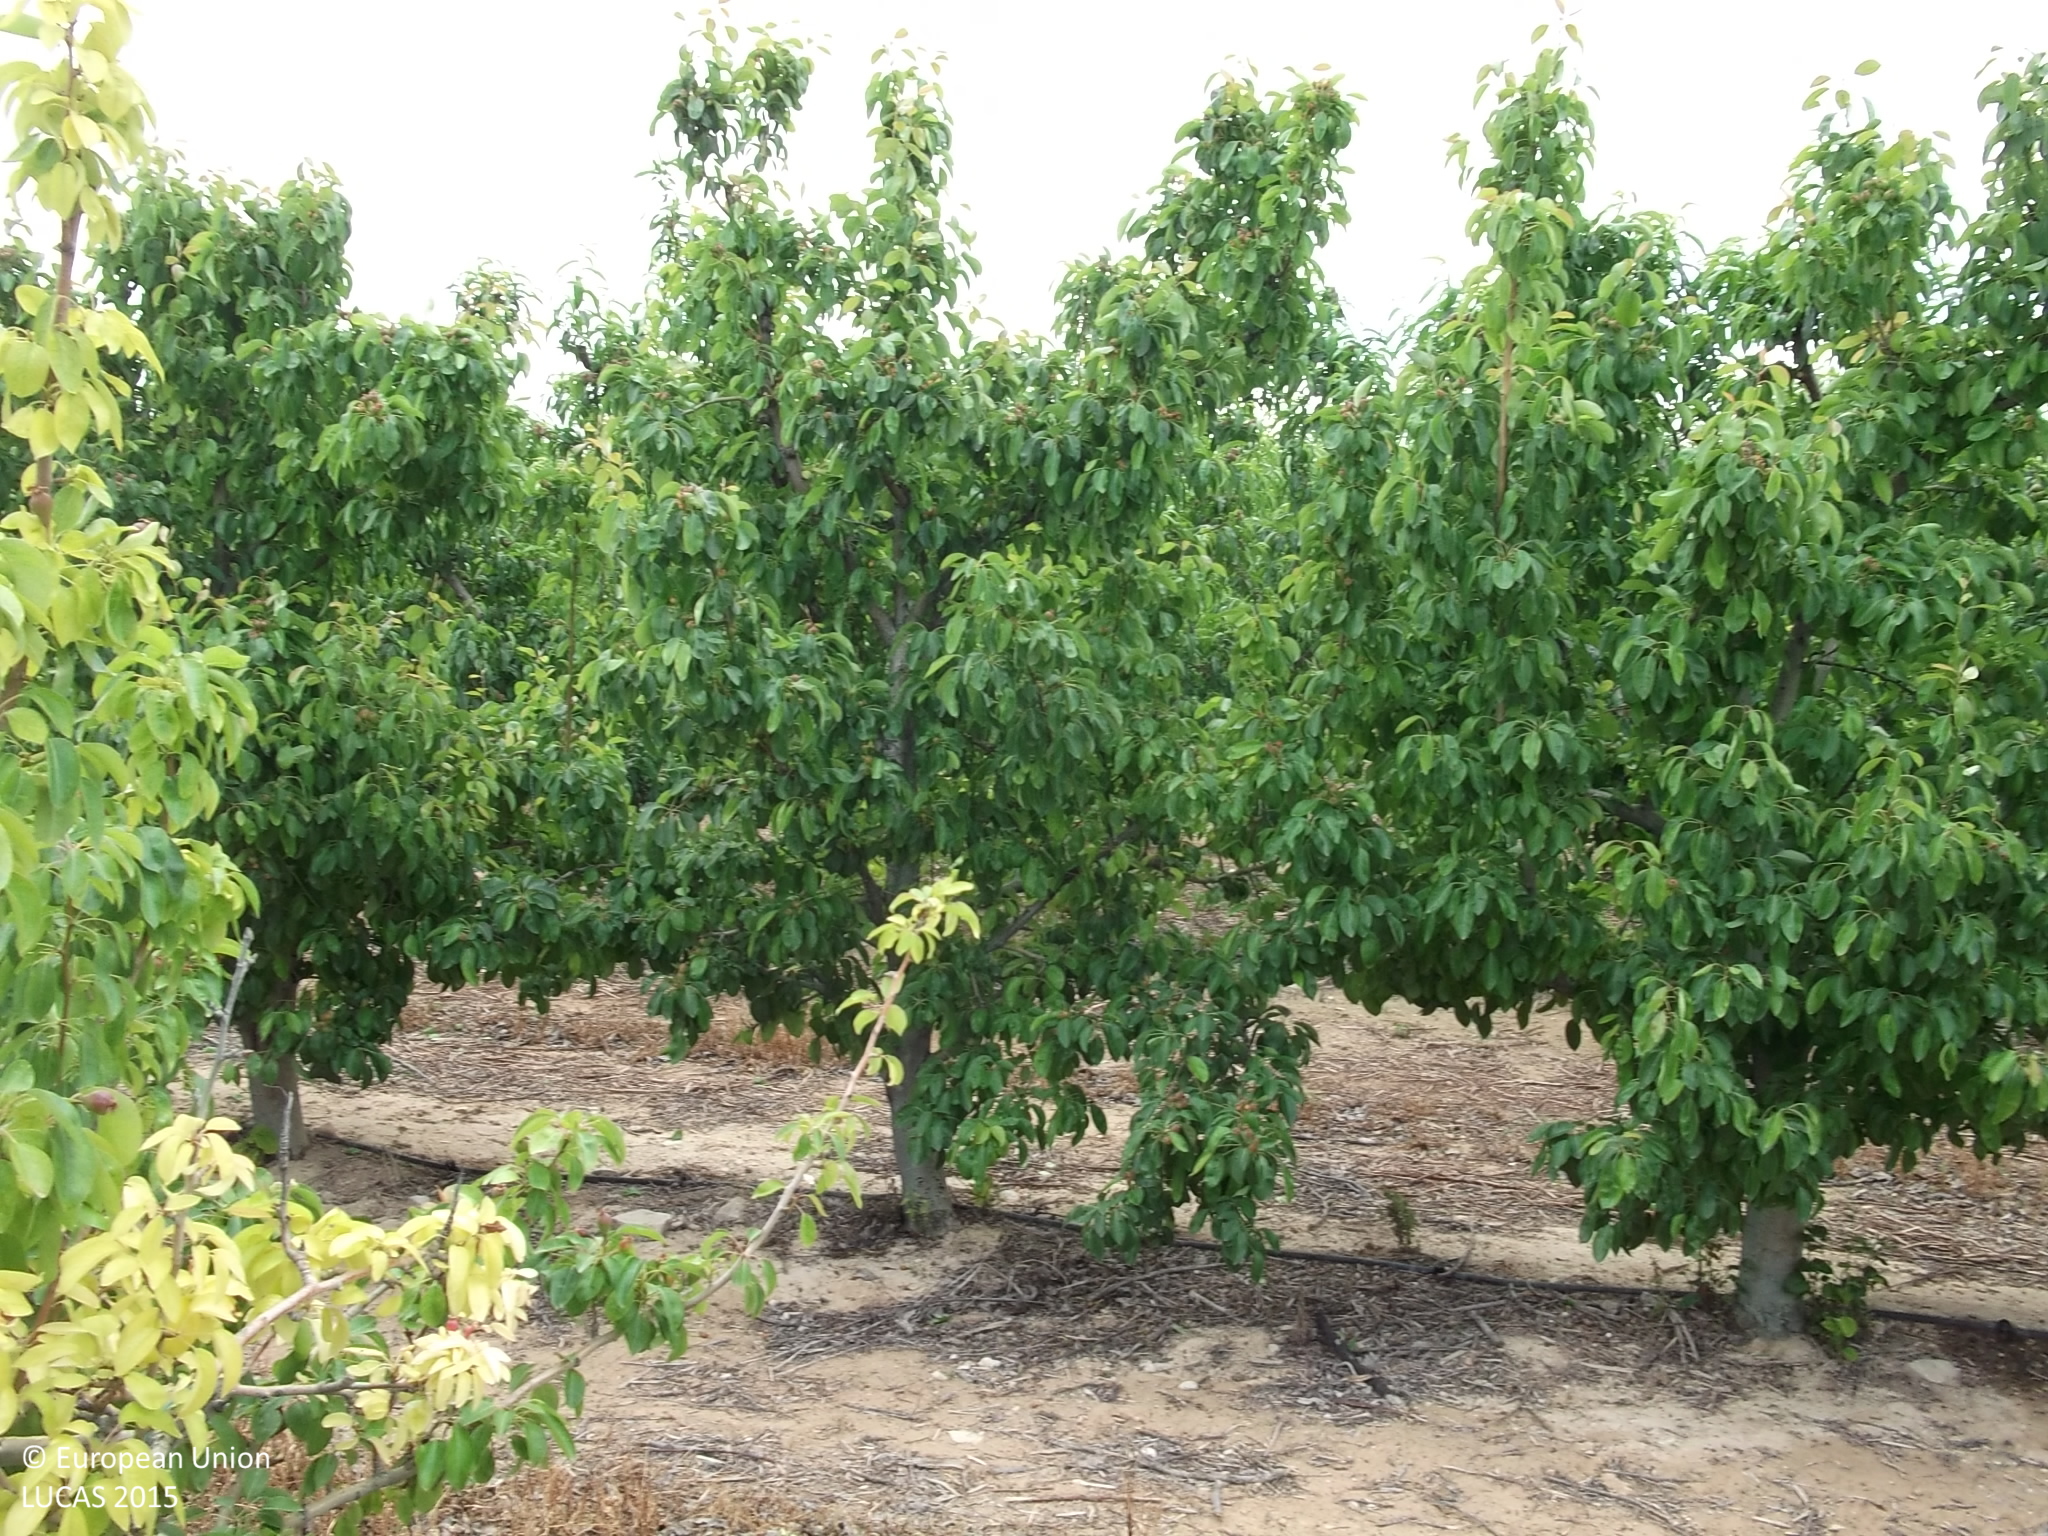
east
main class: Cropland
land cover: Pear fruit
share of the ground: 25 - 50 %
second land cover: Other bare soil
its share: > 75 %
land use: Agriculture (excluding fallow land and kitchen gardens)
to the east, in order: Pear fruit; Other bare soil; Other fruit trees and berries; Tracks; Pear fruit; Tracks; Other fruit trees and berries
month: April
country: ES
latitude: 38.2948
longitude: -1.3196
